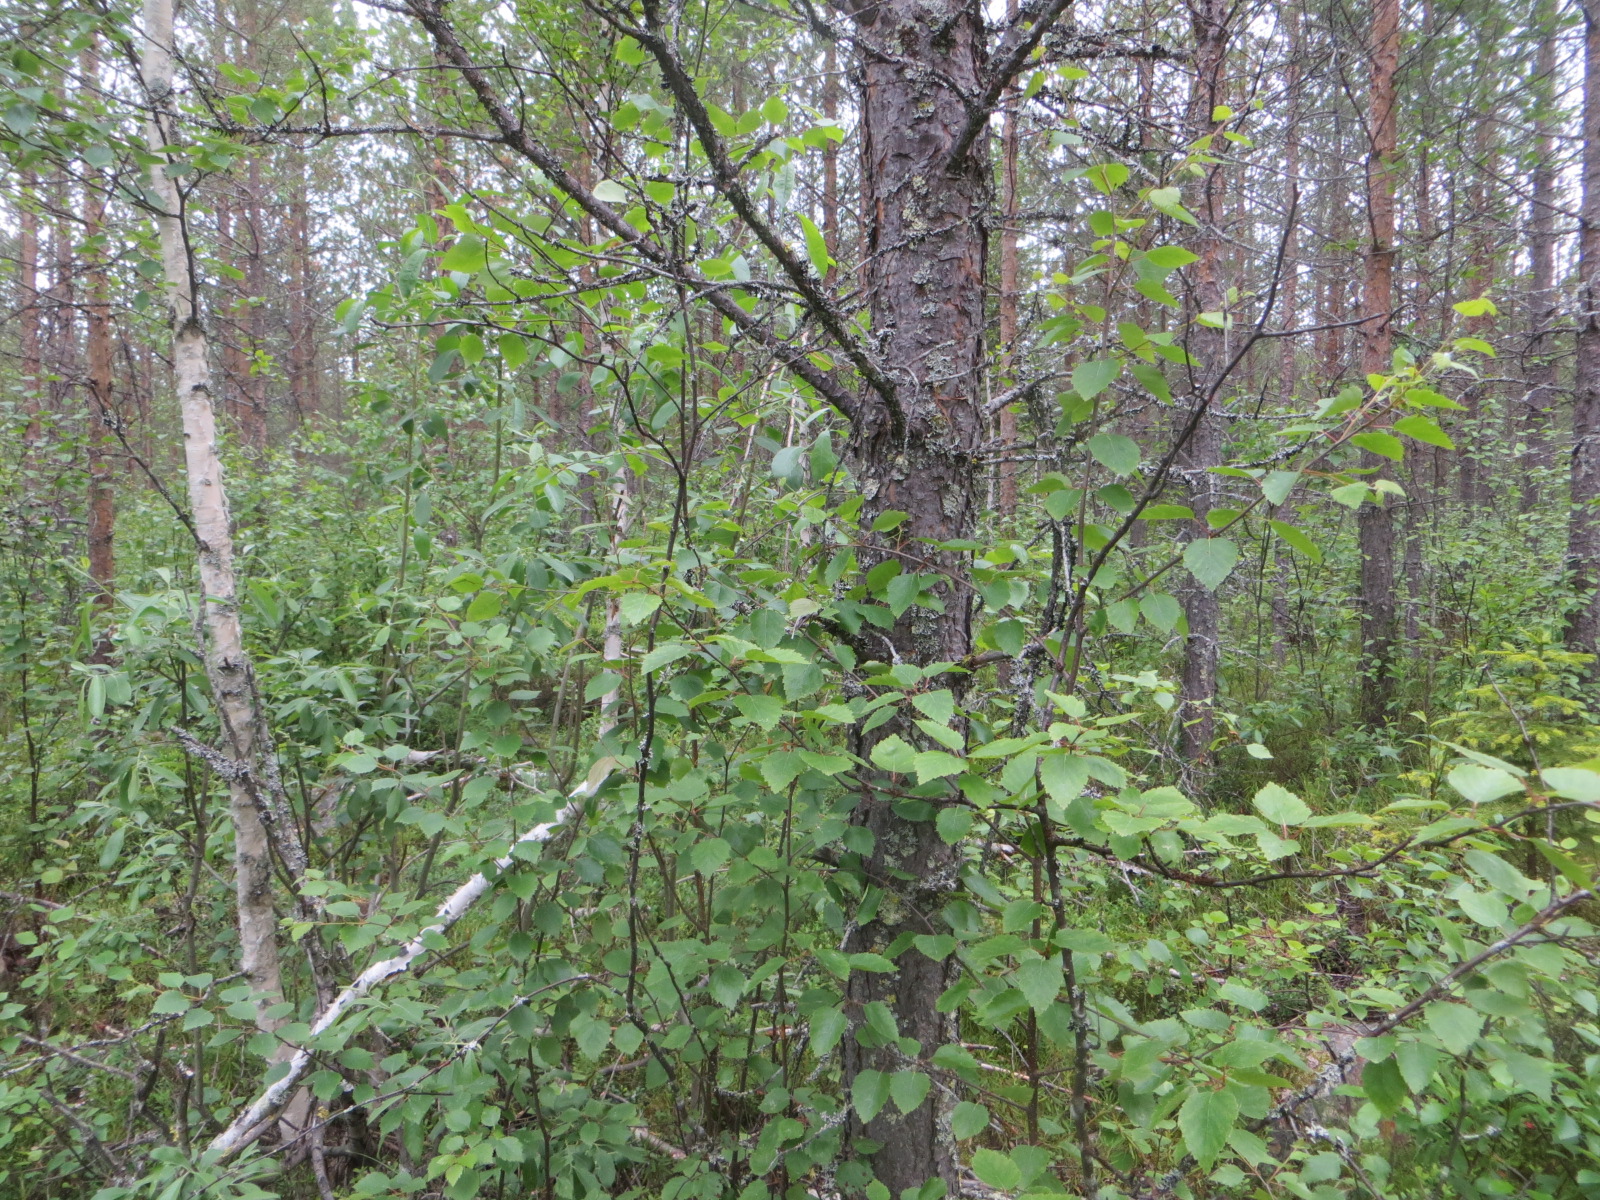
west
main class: Woodland
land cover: Other mixed woodland
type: boreal forest
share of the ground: > 75 %
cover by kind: coniferous forest trees 45 %, broadleaved forest trees 30 %, shrubs 25 %
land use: Forestry
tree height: > 5 m
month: July
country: FI
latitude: 65.8607
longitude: 25.3881
